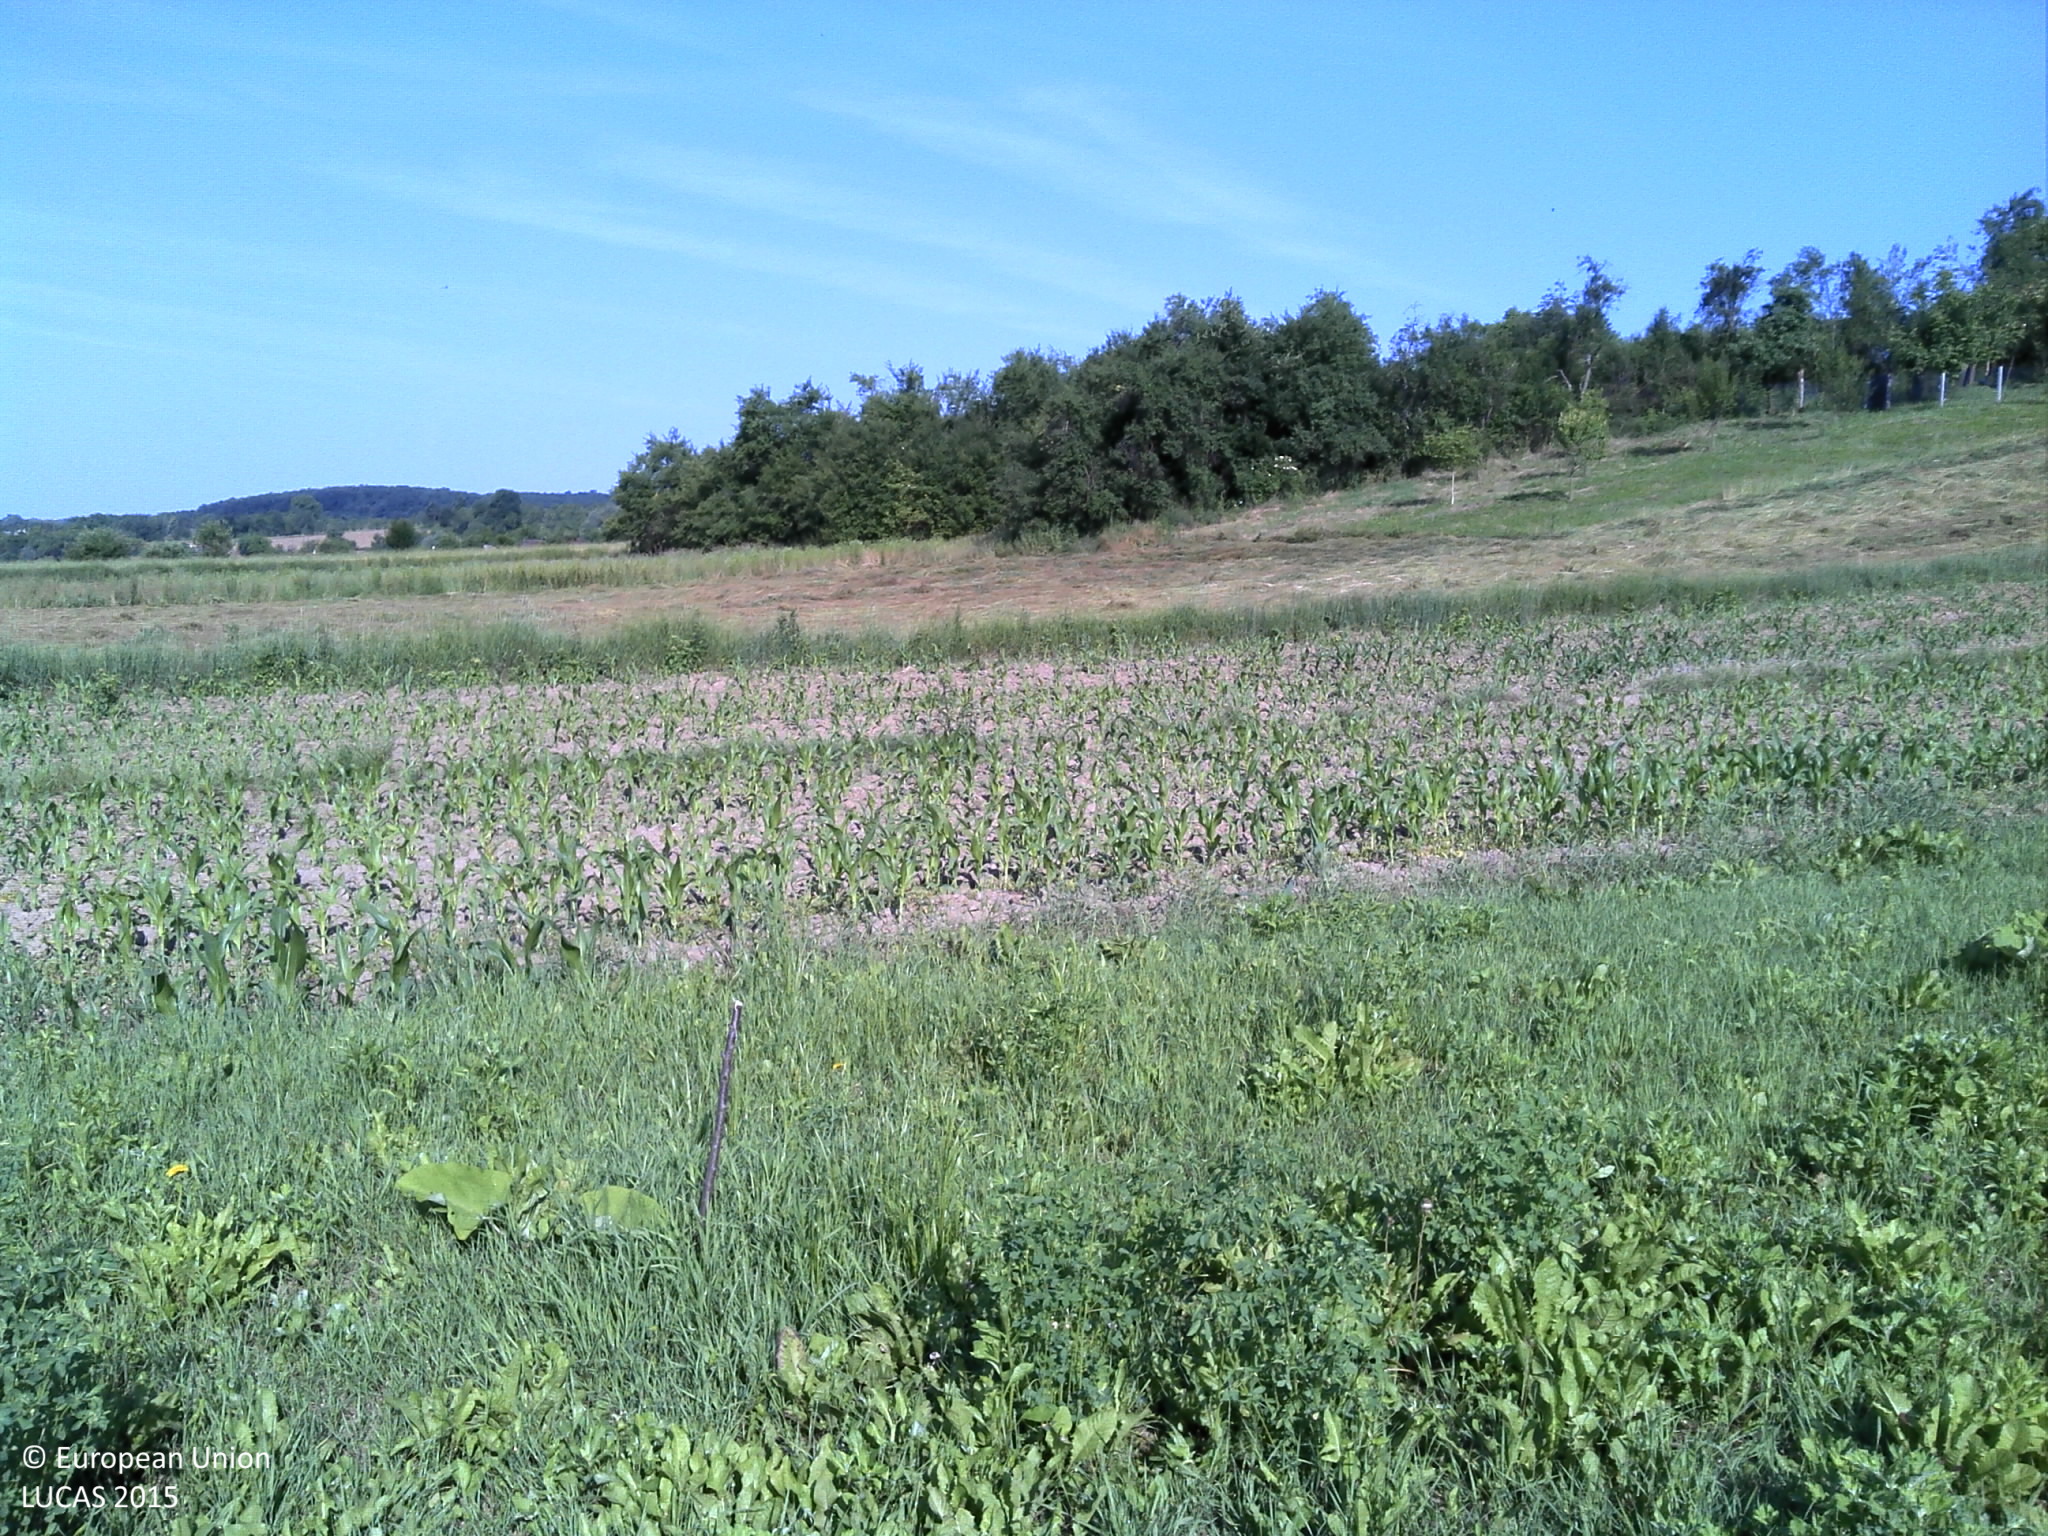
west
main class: Cropland
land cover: Other fruit trees and berries
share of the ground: < 10 %
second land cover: Grassland without tree/shrub cover
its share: > 75 %
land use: Kitchen garden
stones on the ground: < 10 %
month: June
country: HR
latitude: 45.3133
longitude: 18.1802
